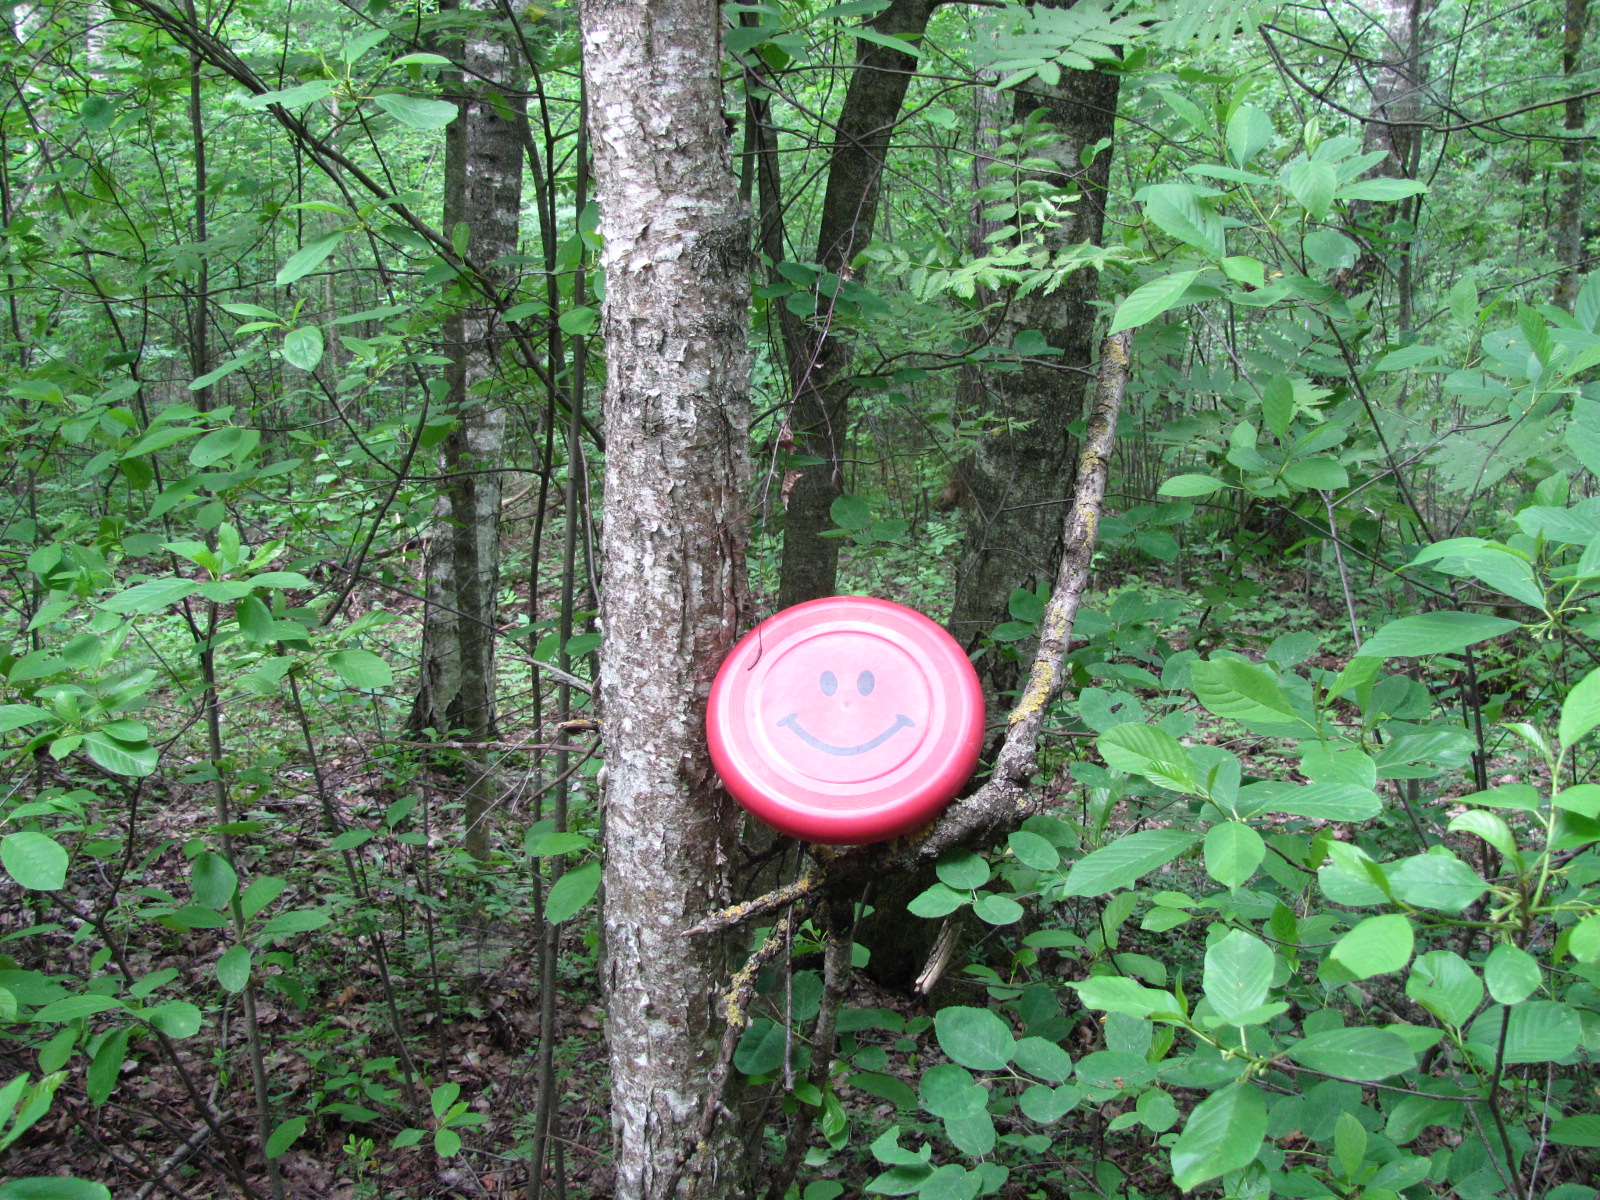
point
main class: Woodland
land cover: Broadleaved woodland
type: non-riverine alder, birch or aspen forest
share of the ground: > 75 %
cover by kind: broadleaved forest trees 100 %
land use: Forestry
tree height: > 5 m
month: June
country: LV
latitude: 56.6336
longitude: 23.8907
